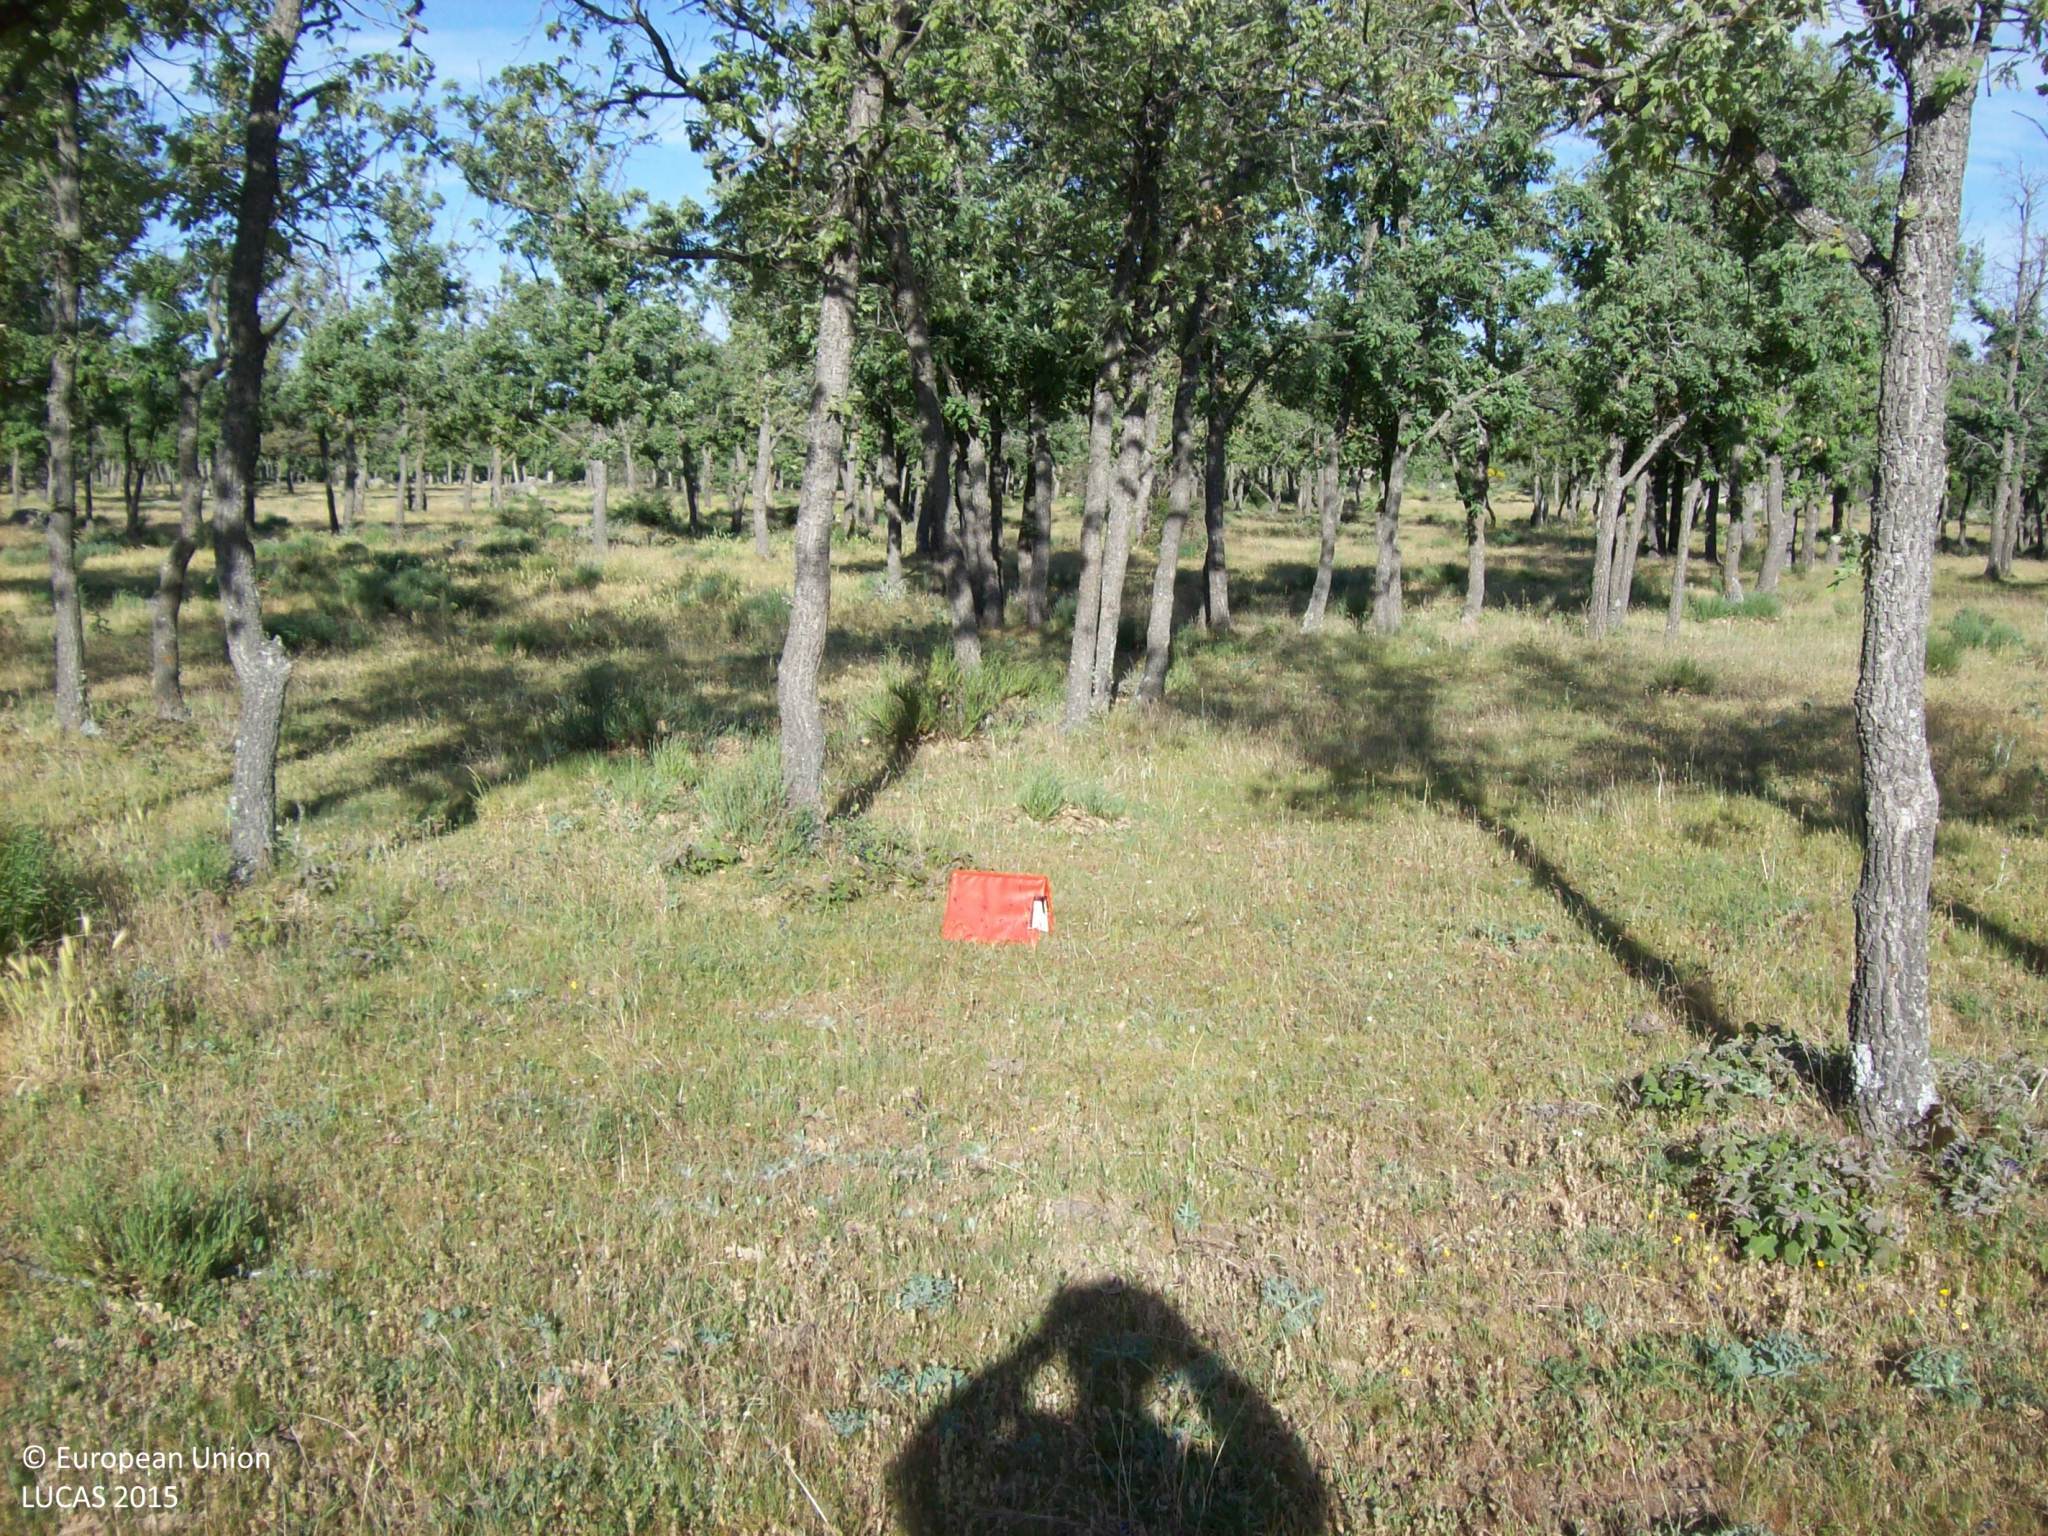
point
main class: Woodland
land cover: Broadleaved woodland
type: thermophilous deciduous forest
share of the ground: 25 - 50 %
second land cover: Grassland without tree/shrub cover
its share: > 75 %
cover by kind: herbaceous plants 55 %, broadleaved forest trees 40 %, shrubs 5 %
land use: Forestry
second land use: Agriculture (excluding fallow land and kitchen gardens)
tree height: < 5 m
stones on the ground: < 10 %
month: May
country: ES
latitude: 40.7690
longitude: -4.4474
